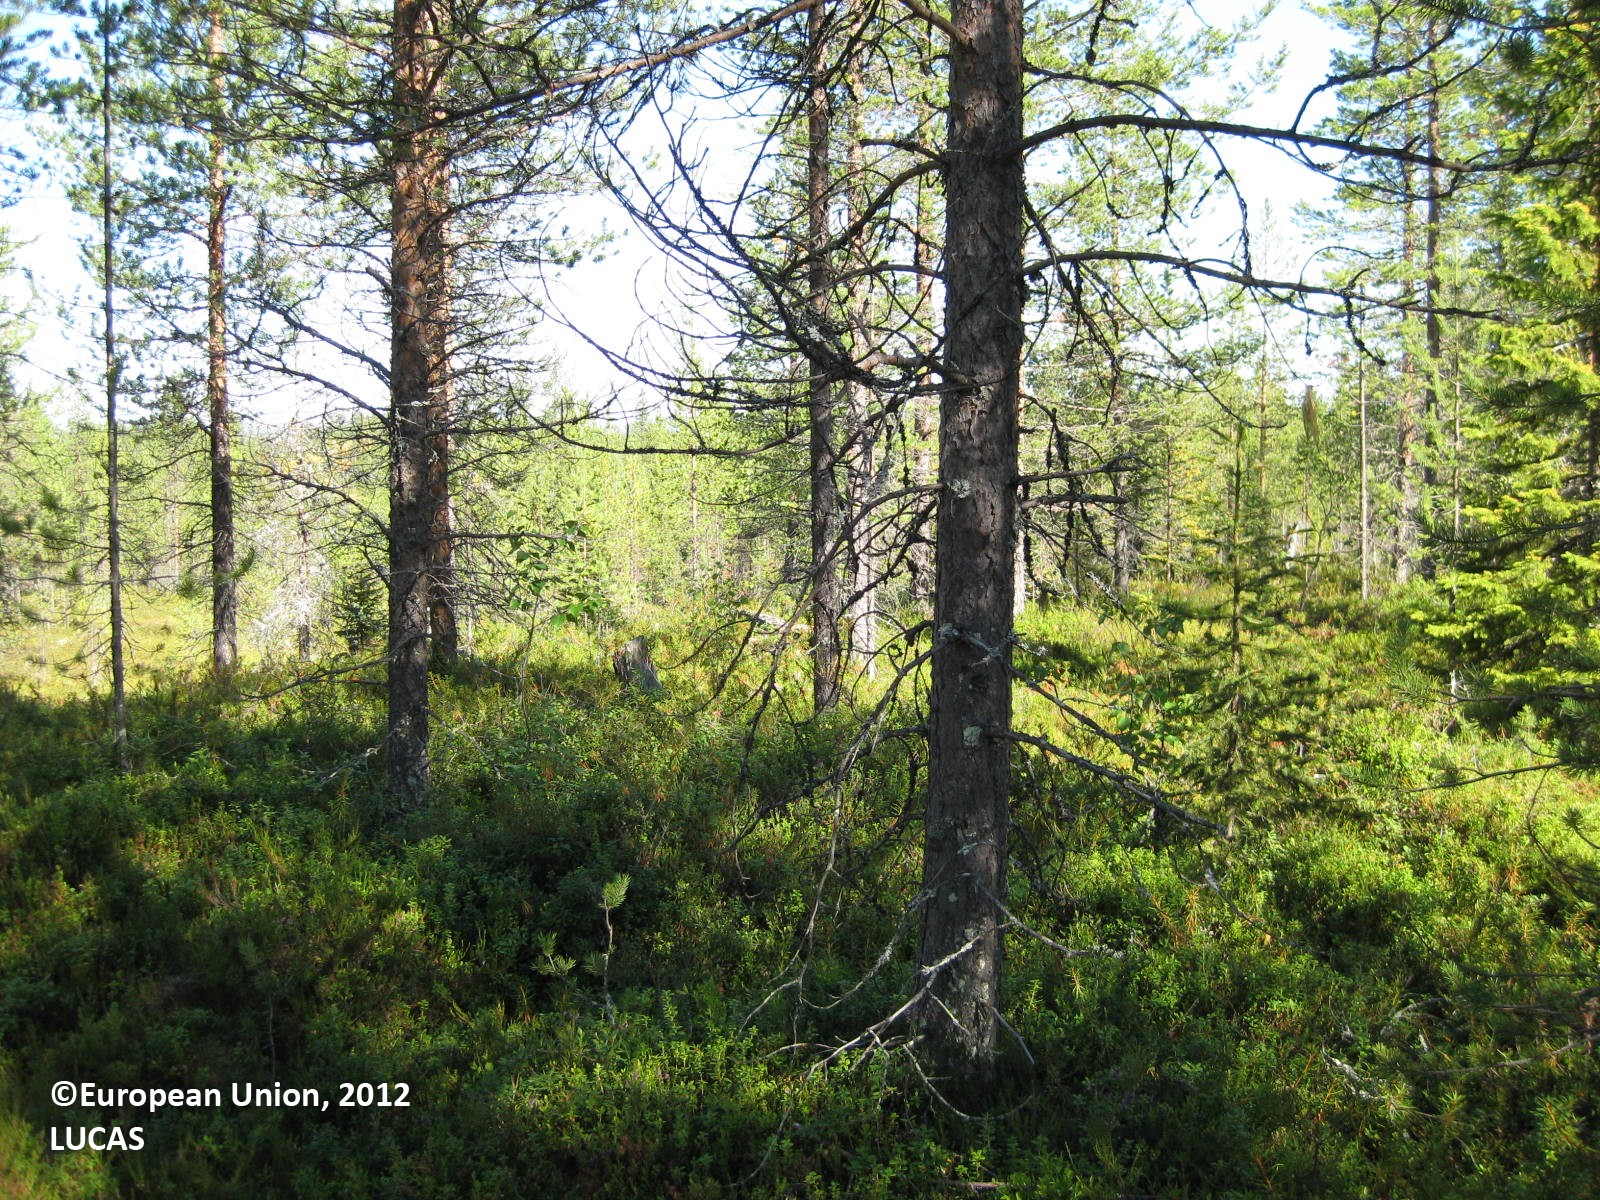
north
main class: Woodland
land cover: Pine dominated coniferous woodland
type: boreal forest
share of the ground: 50 - 75 %
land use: Forestry
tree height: > 5 m
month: August
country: FI
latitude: 66.5051
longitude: 28.5577
